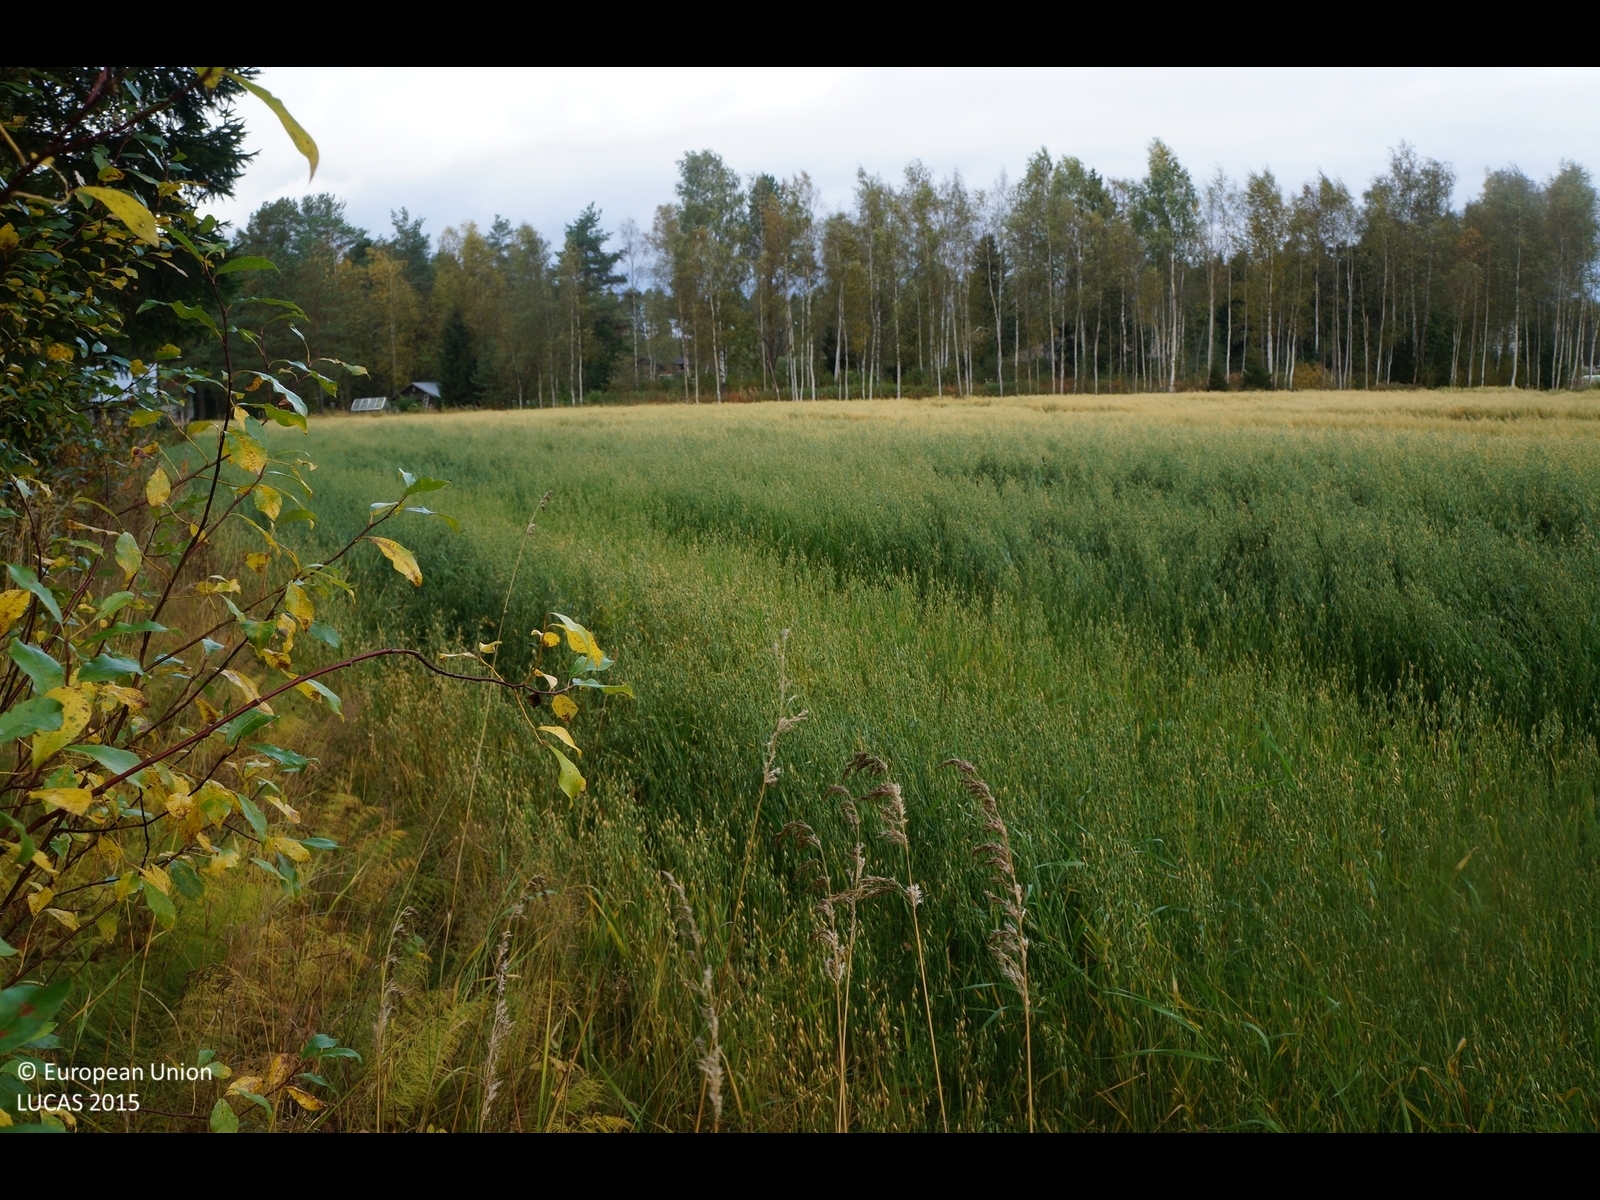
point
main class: Cropland
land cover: Oats
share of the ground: > 75 %
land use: Agriculture (excluding fallow land and kitchen gardens)
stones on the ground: < 10 %
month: September
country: FI
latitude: 63.8506
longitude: 23.3362
